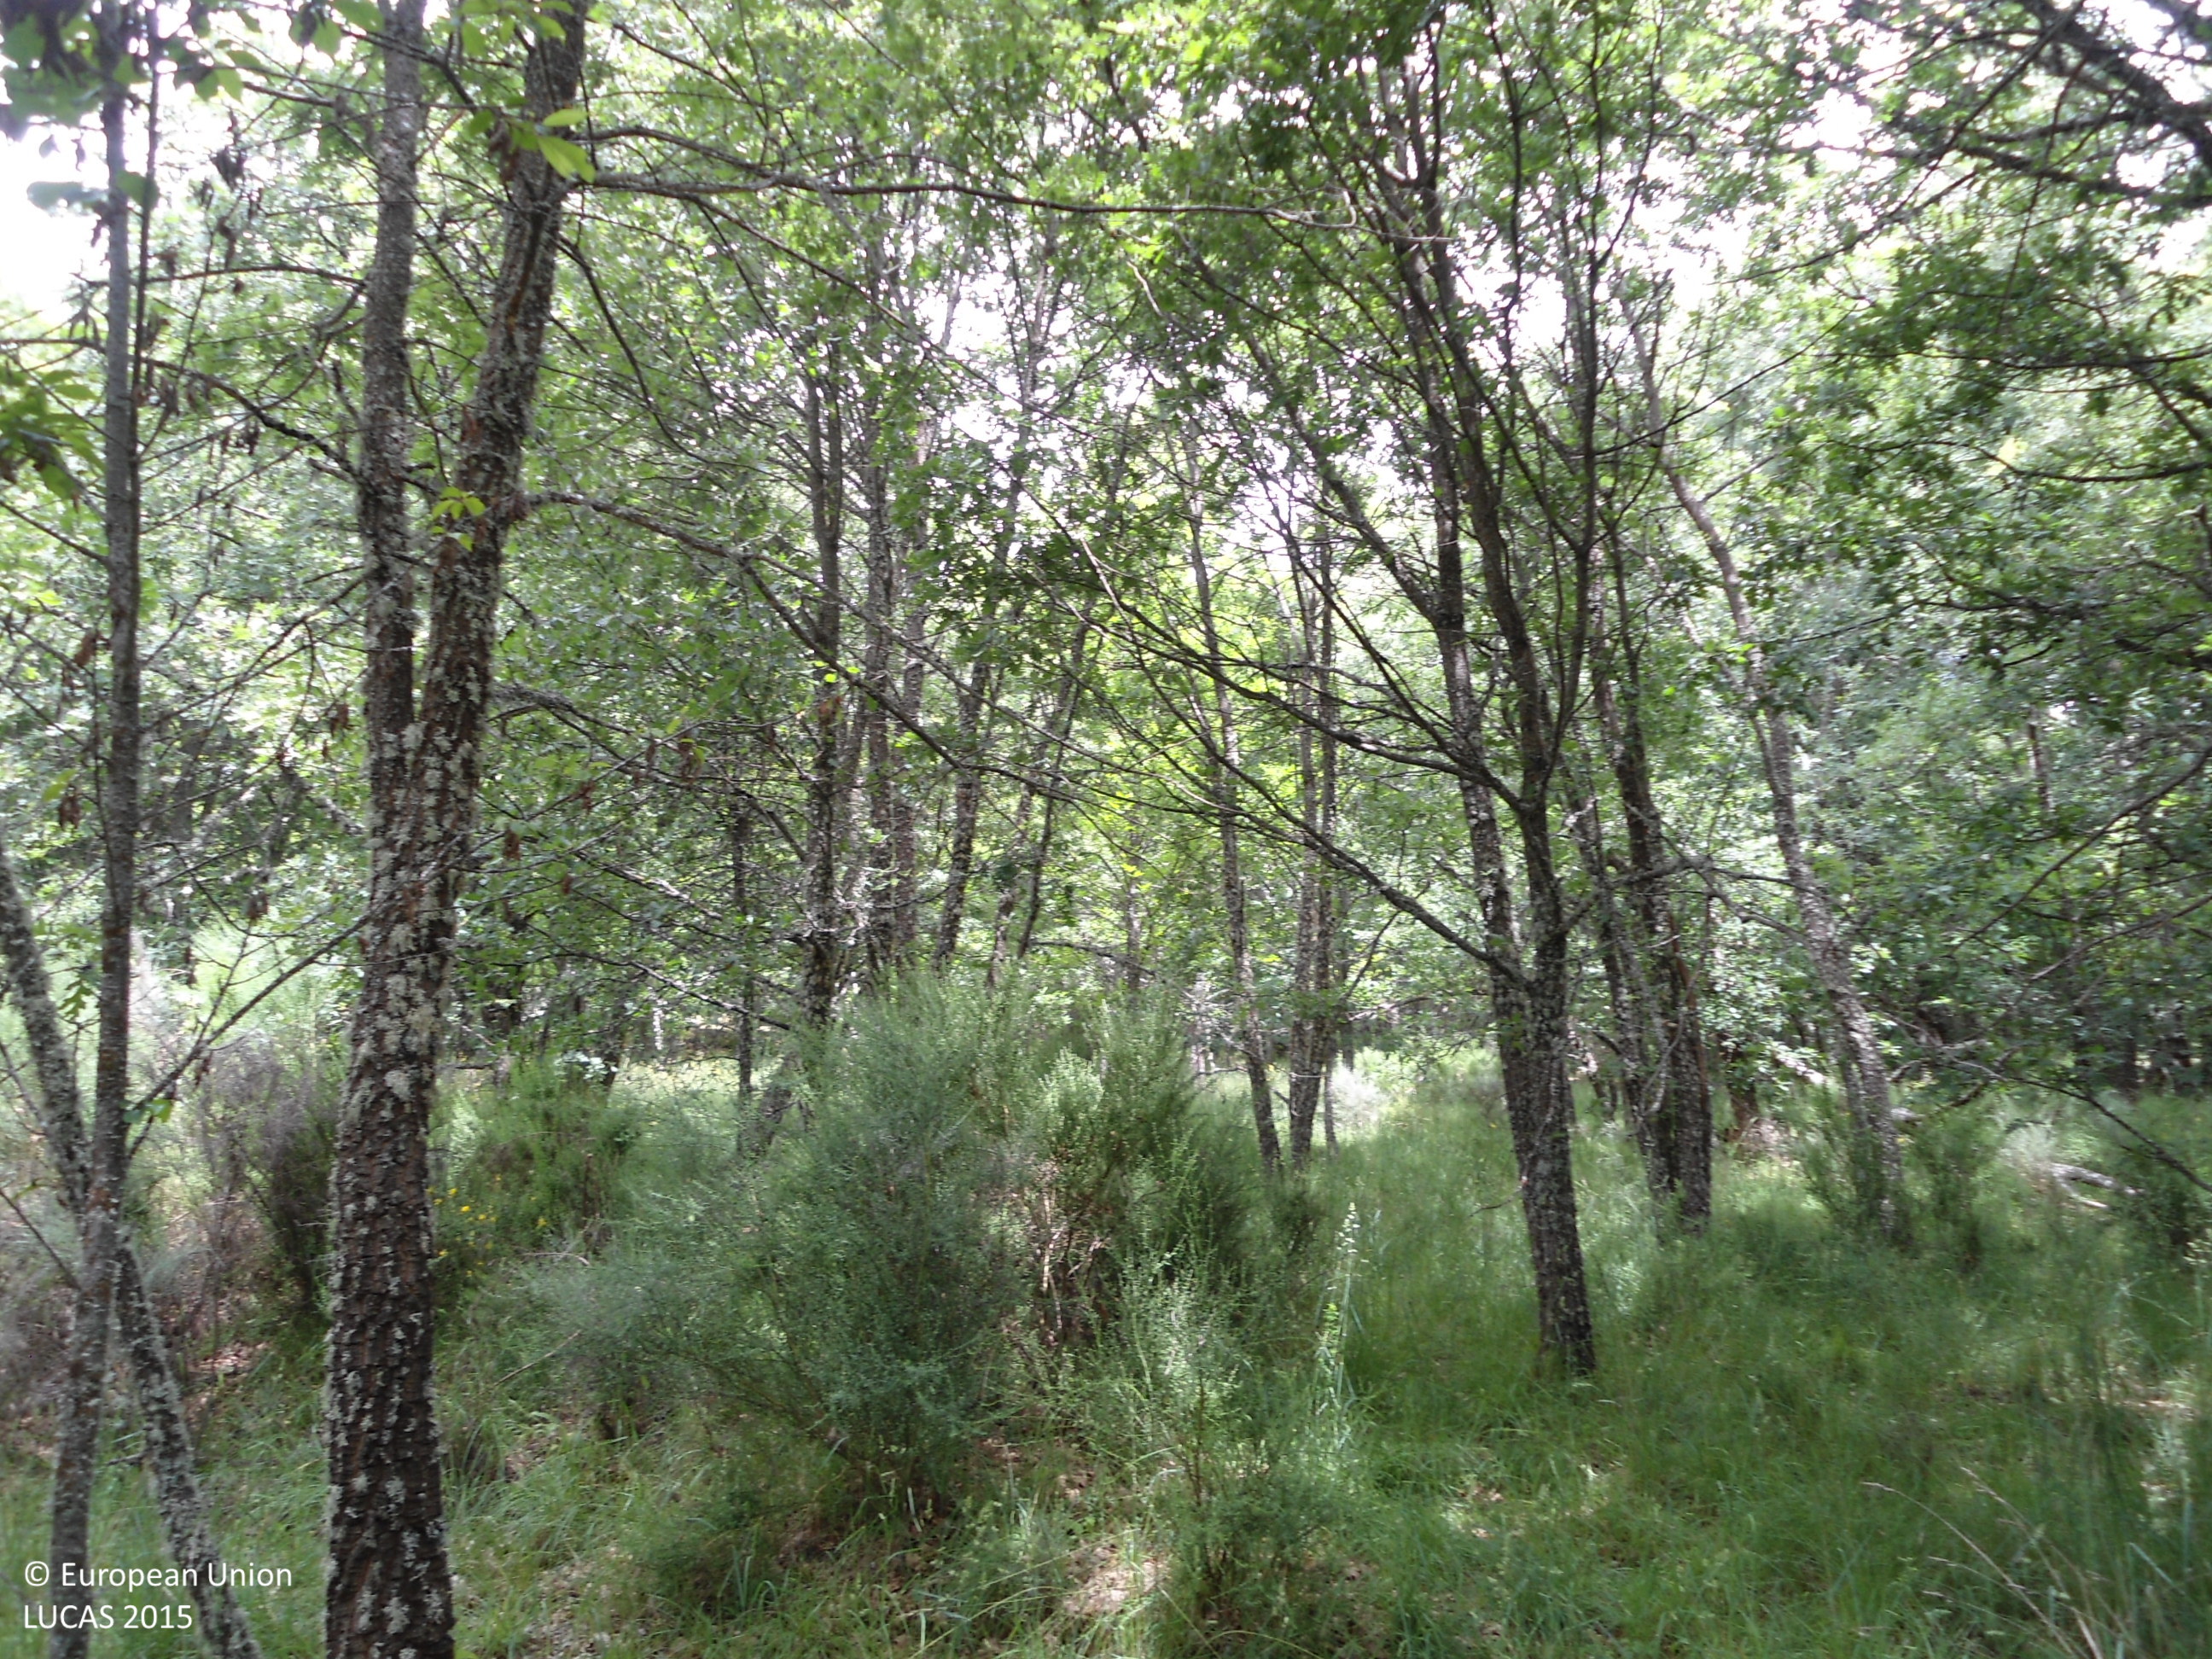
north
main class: Woodland
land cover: Broadleaved woodland
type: thermophilous deciduous forest
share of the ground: > 75 %
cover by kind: broadleaved forest trees 100 %
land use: Forestry
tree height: > 5 m
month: June
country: ES
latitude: 42.0842
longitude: -6.5901
